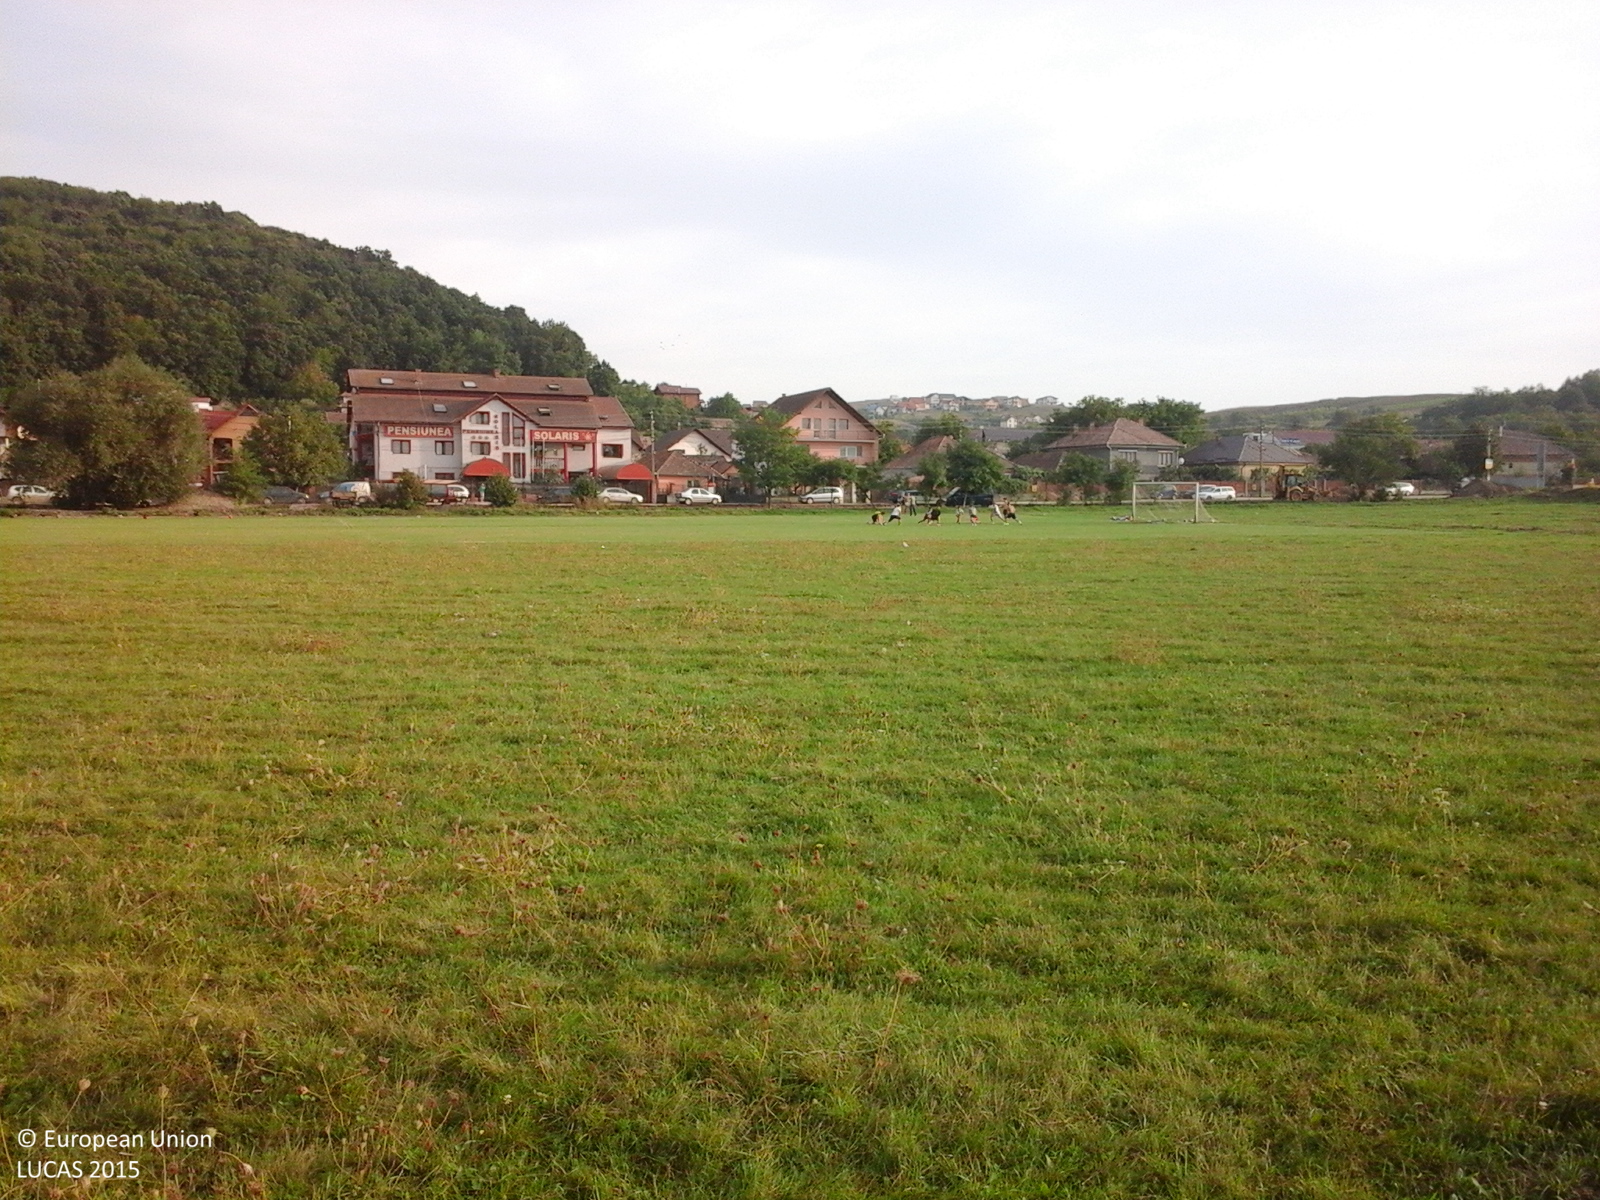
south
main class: Grassland
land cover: Grassland without tree/shrub cover
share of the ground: > 75 %
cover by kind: herbaceous plants 100 %
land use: Agriculture (excluding fallow land and kitchen gardens)
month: September
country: RO
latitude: 46.7782
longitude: 23.7073
